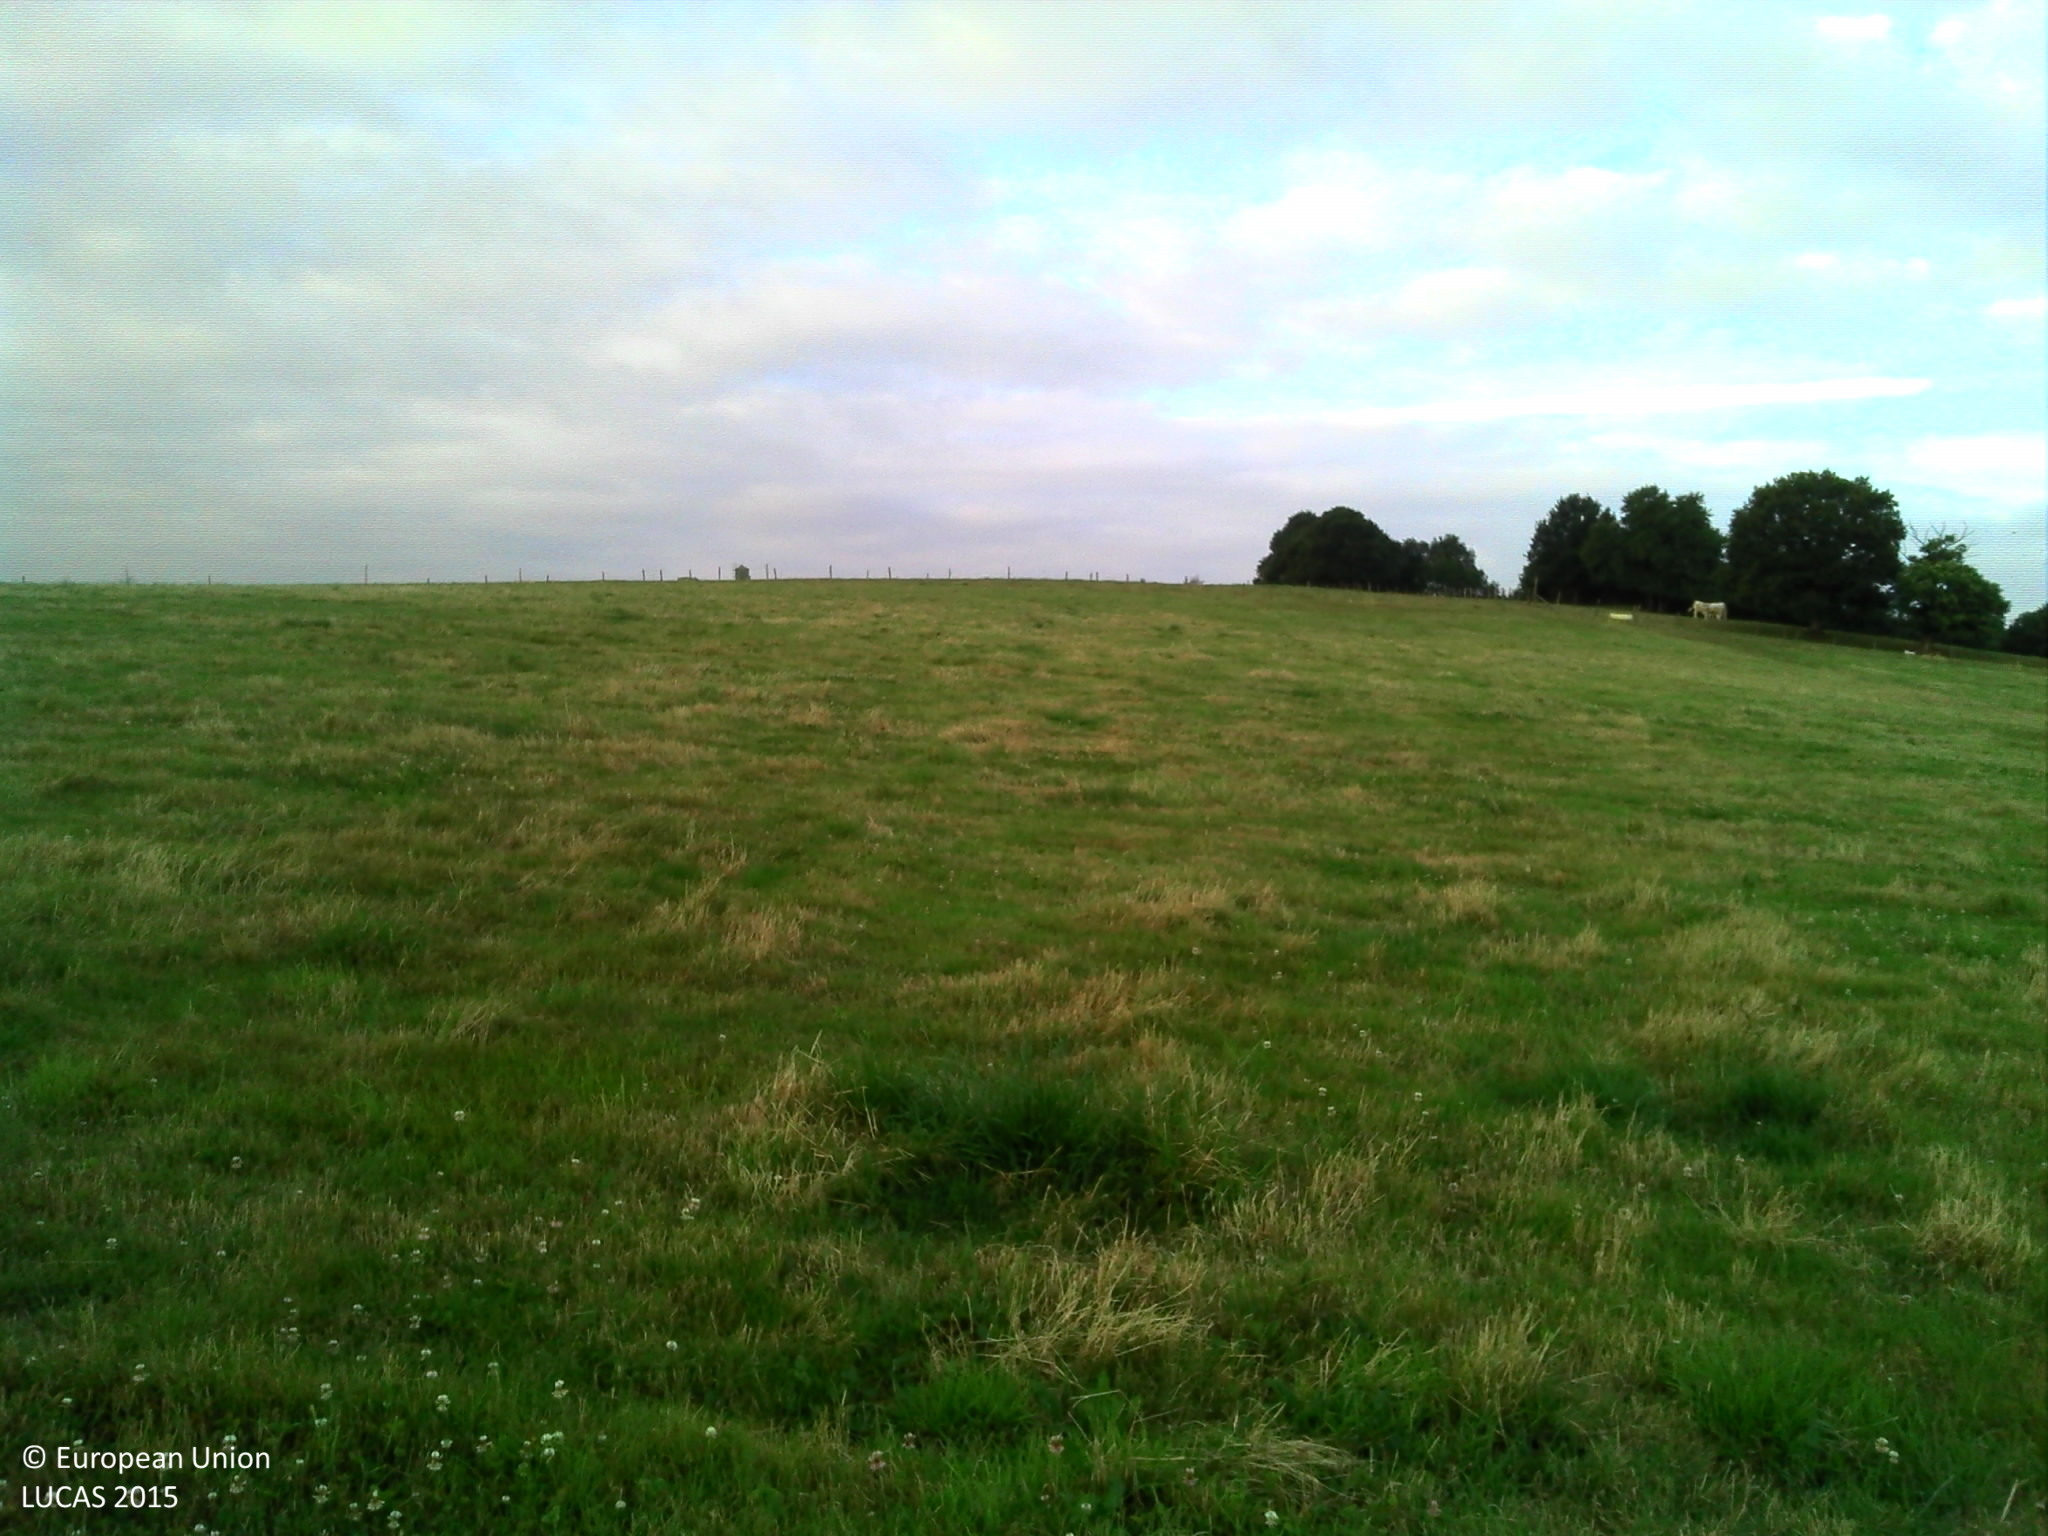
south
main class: Grassland
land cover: Grassland without tree/shrub cover
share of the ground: > 75 %
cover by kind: herbaceous plants 100 %
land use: Agriculture (excluding fallow land and kitchen gardens)
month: June
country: FR
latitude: 47.9708
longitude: -1.4434
